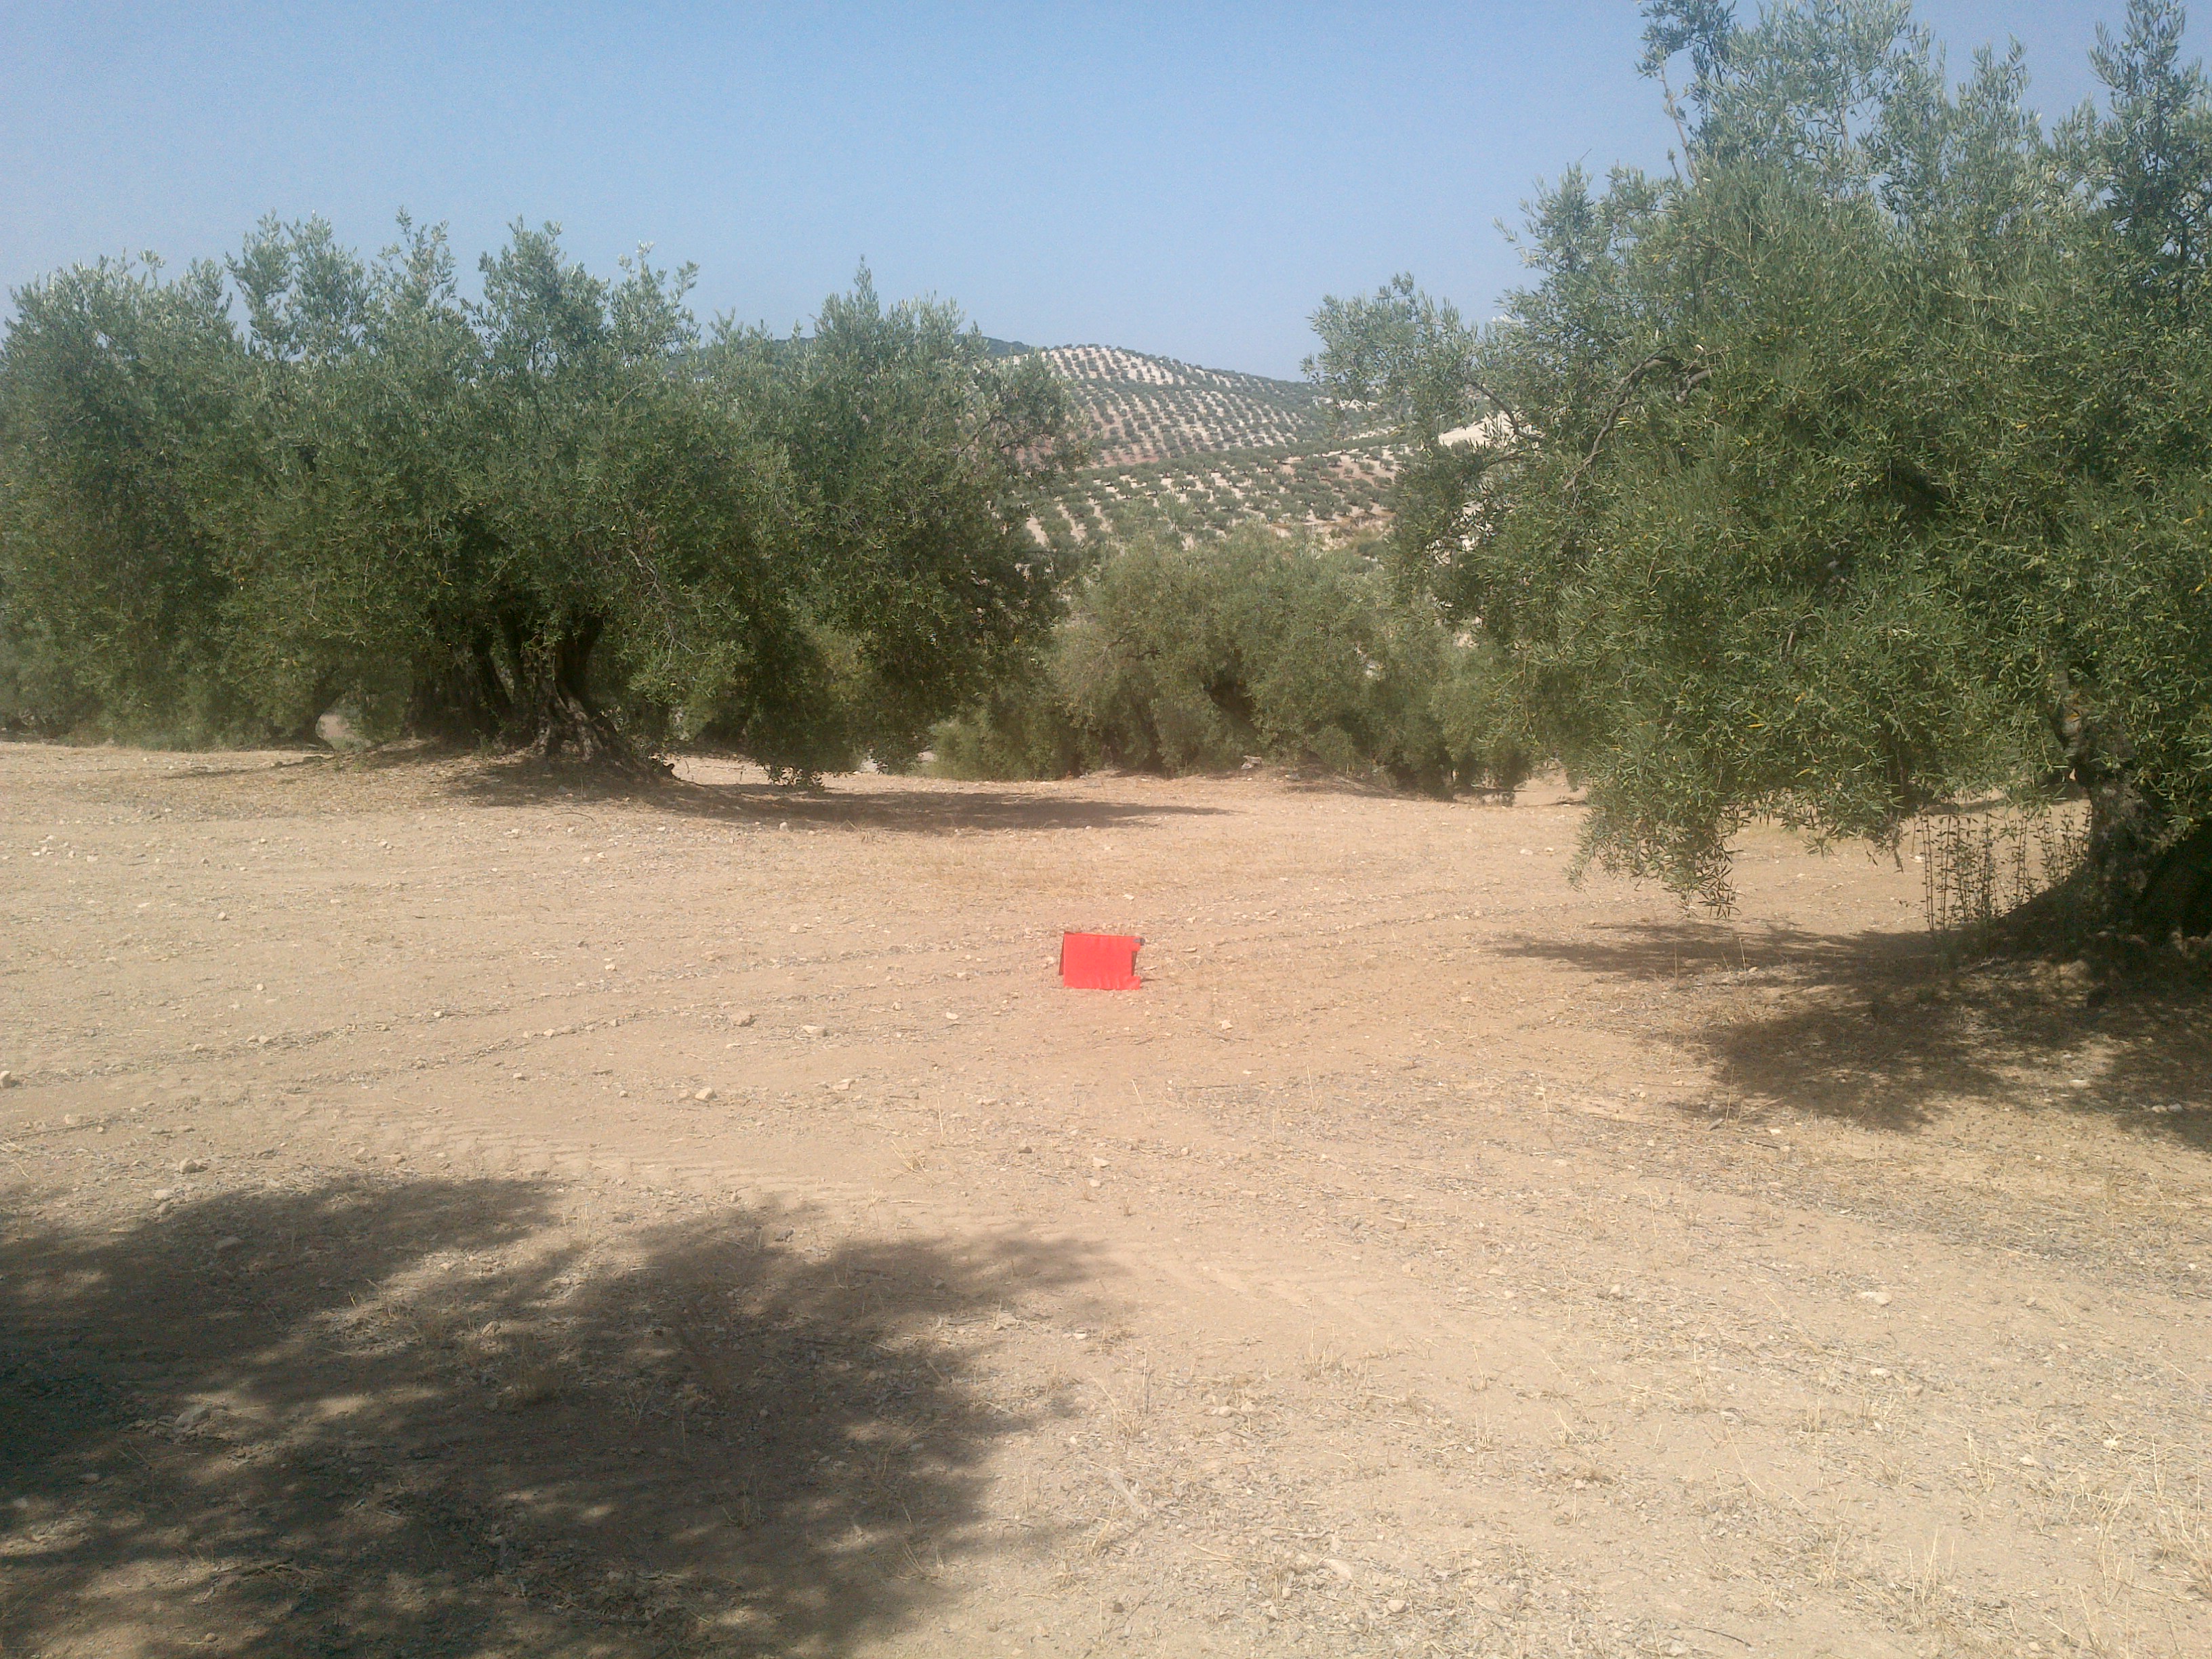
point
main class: Cropland
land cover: Olive groves
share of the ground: 50 - 75 %
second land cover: Other bare soil
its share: > 75 %
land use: Agriculture (excluding fallow land and kitchen gardens)
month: July
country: ES
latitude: 37.5655
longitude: -4.3937
